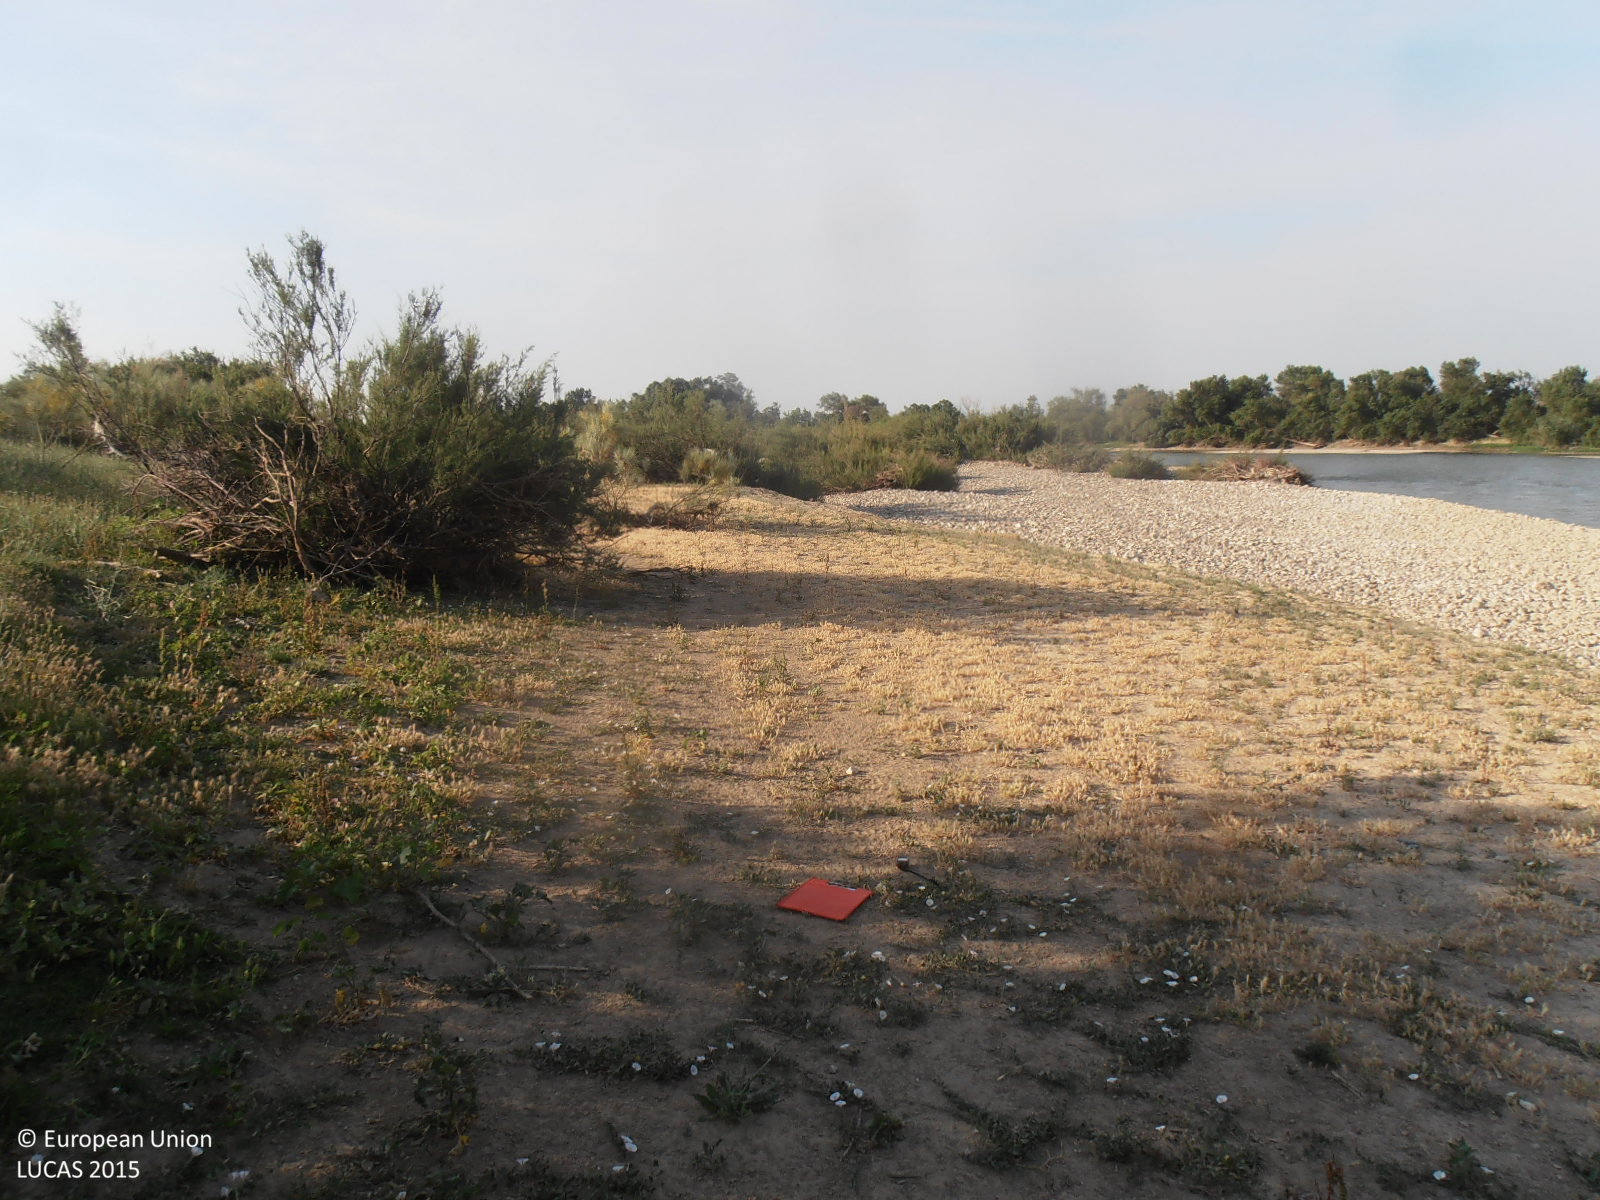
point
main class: Shrubland
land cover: Shrubland without tree cover
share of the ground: 10 - 25 %
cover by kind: herbaceous plants 60 %, shrubs 20 %, unconsolidated bare surface 20 %
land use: Semi-natural and natural areas not in use
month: June
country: ES
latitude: 41.7280
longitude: -0.9750
